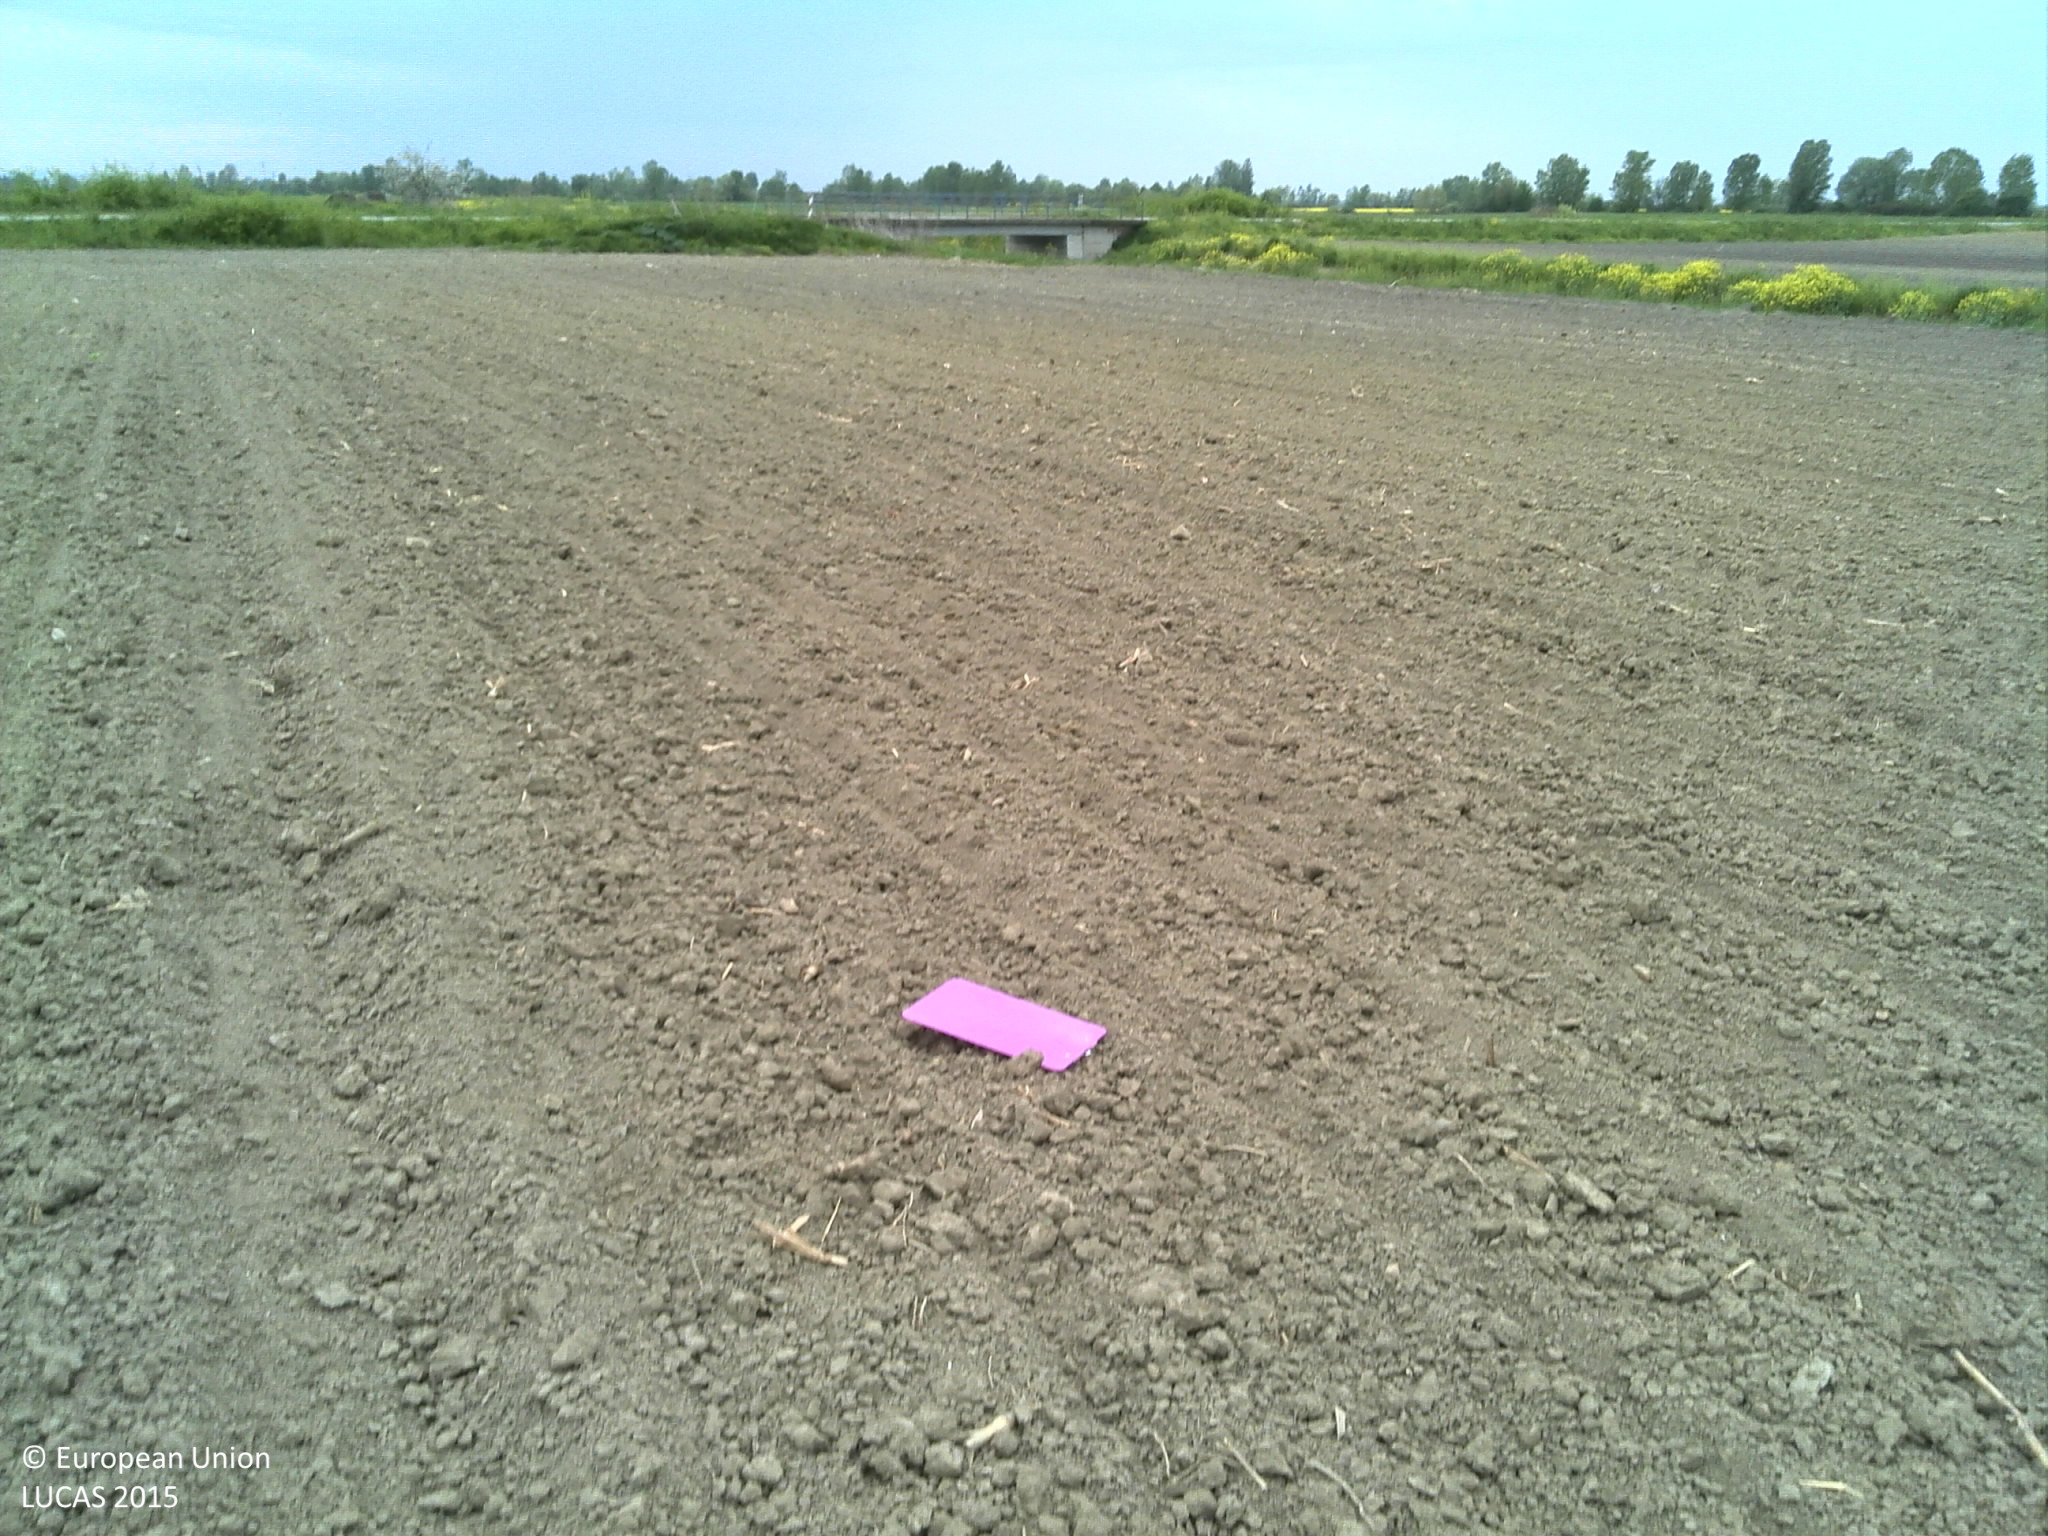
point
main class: Cropland
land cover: Soya
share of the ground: < 10 %
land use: Agriculture (excluding fallow land and kitchen gardens)
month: April
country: HR
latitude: 44.9388
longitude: 18.9915
